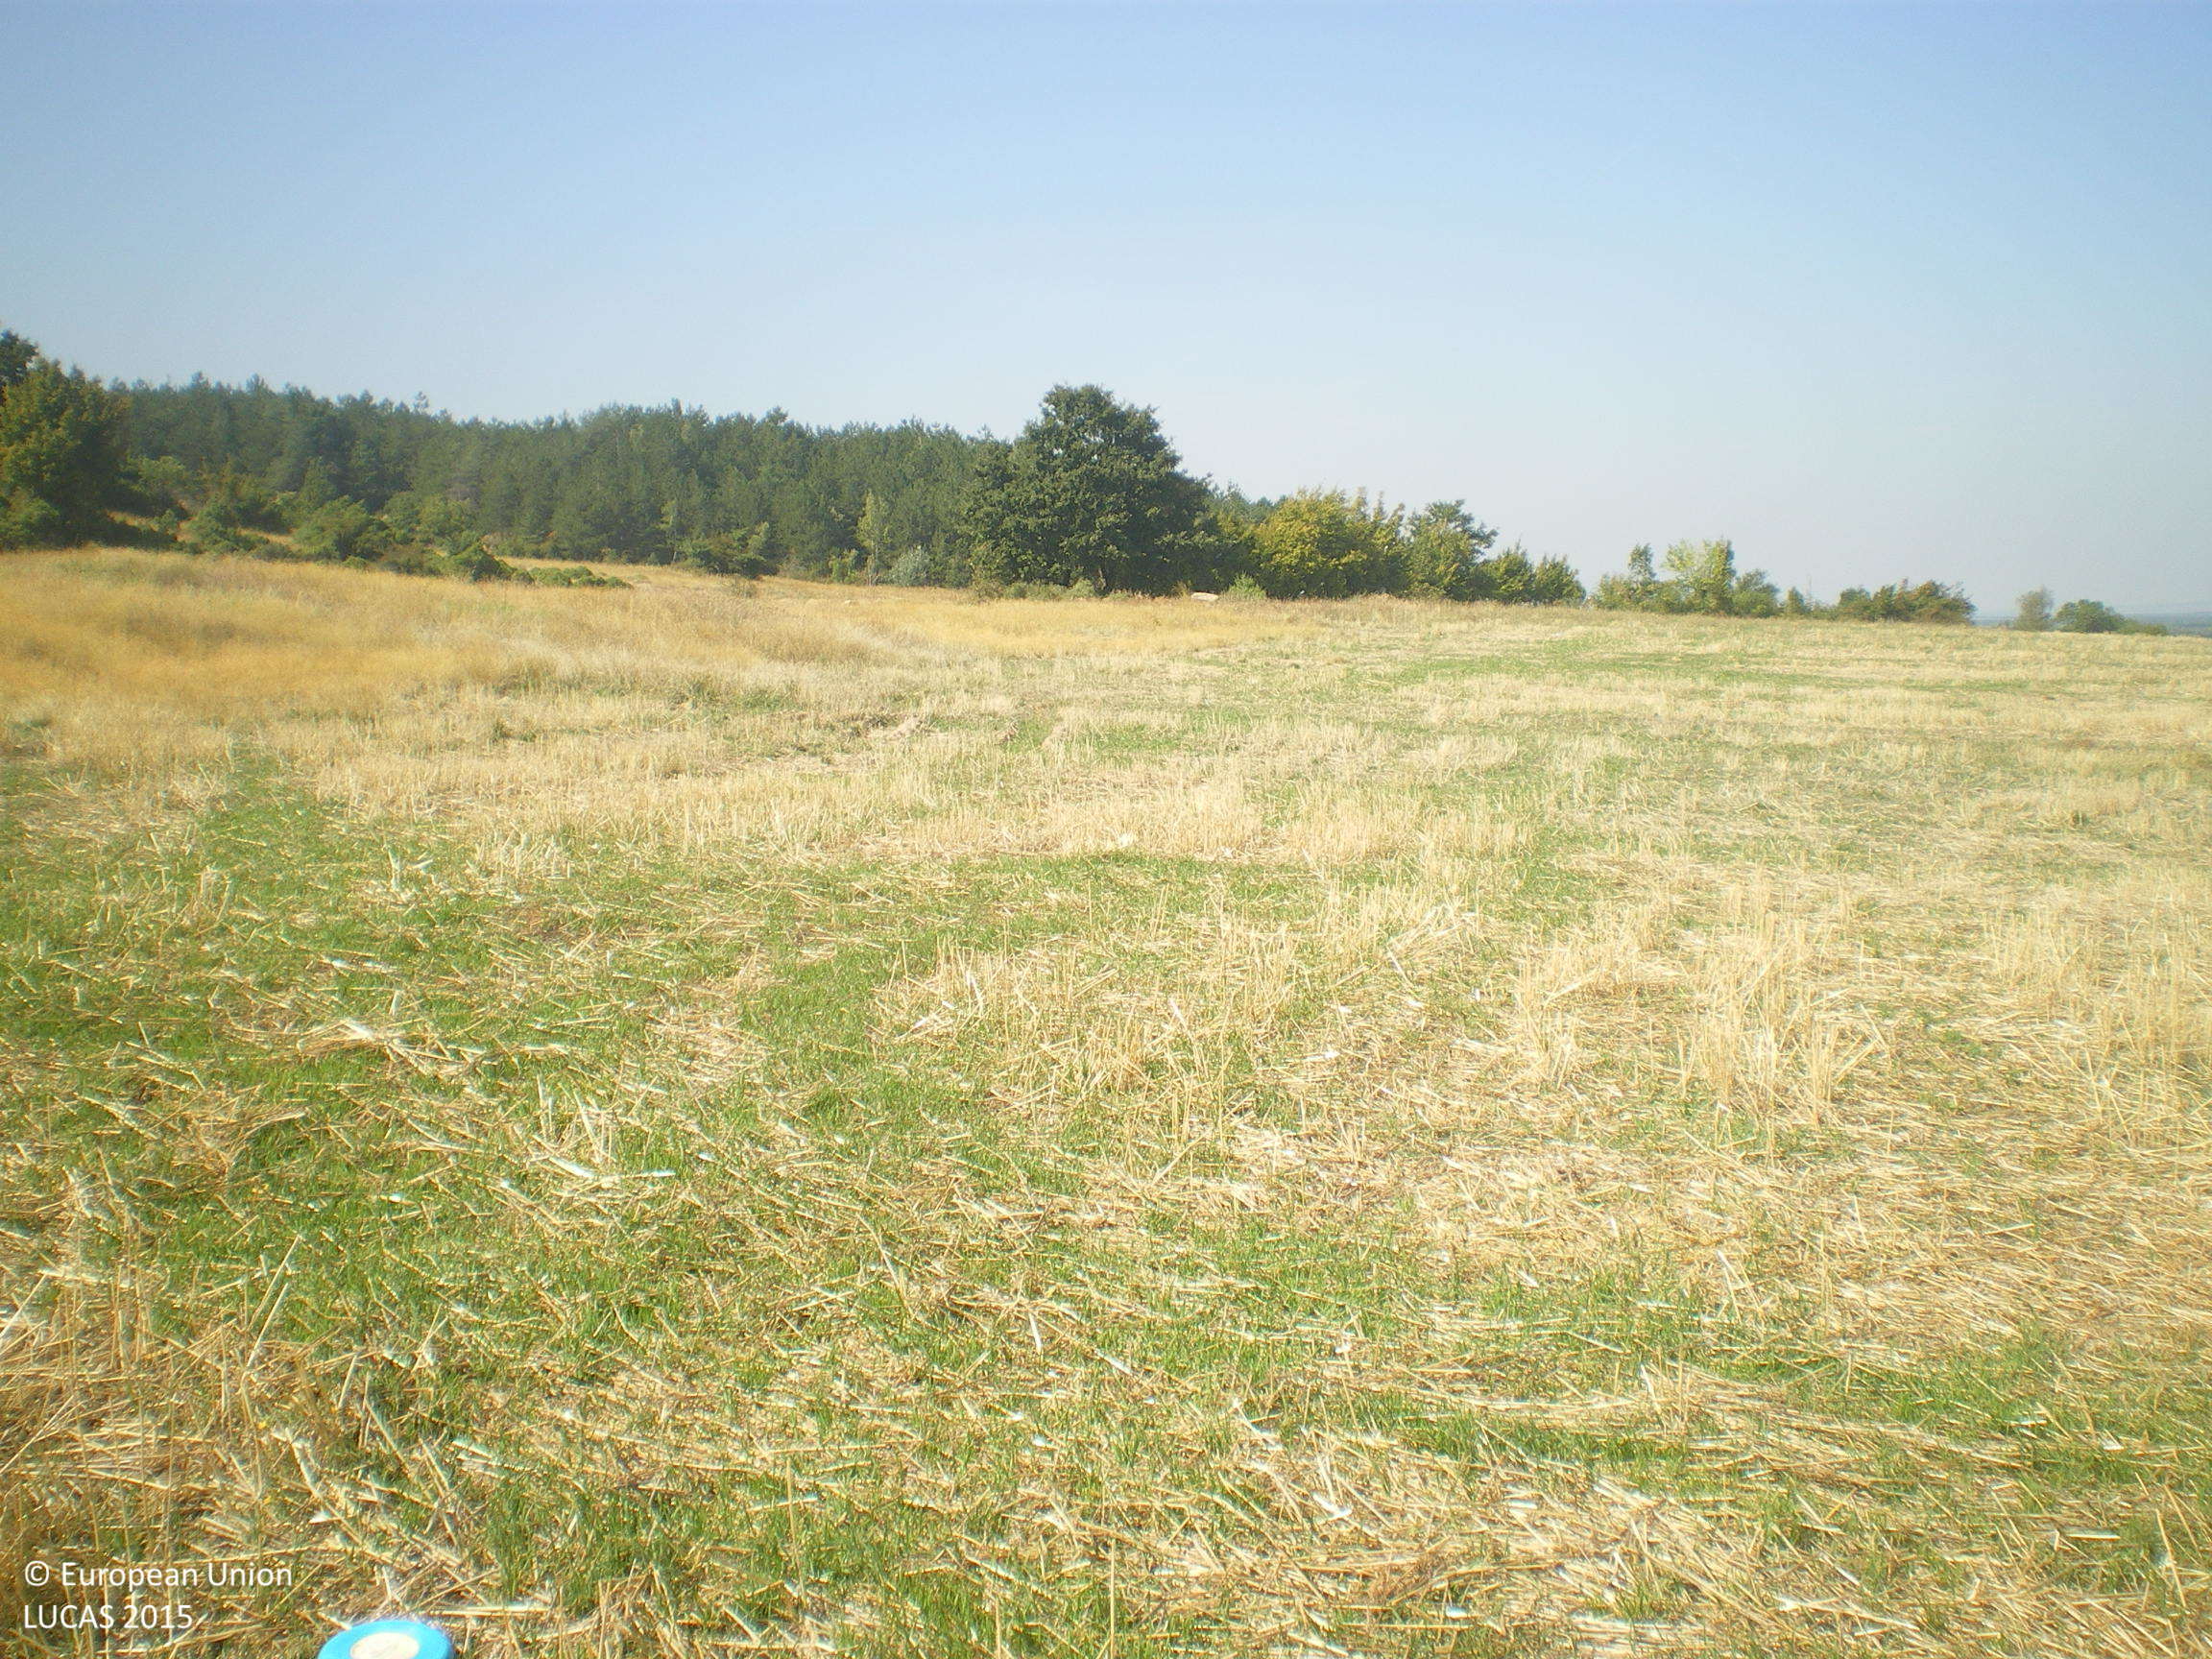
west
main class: Cropland
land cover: Common wheat
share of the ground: 10 - 25 %
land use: Agriculture (excluding fallow land and kitchen gardens)
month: September
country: BG
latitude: 41.7572
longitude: 26.0074
